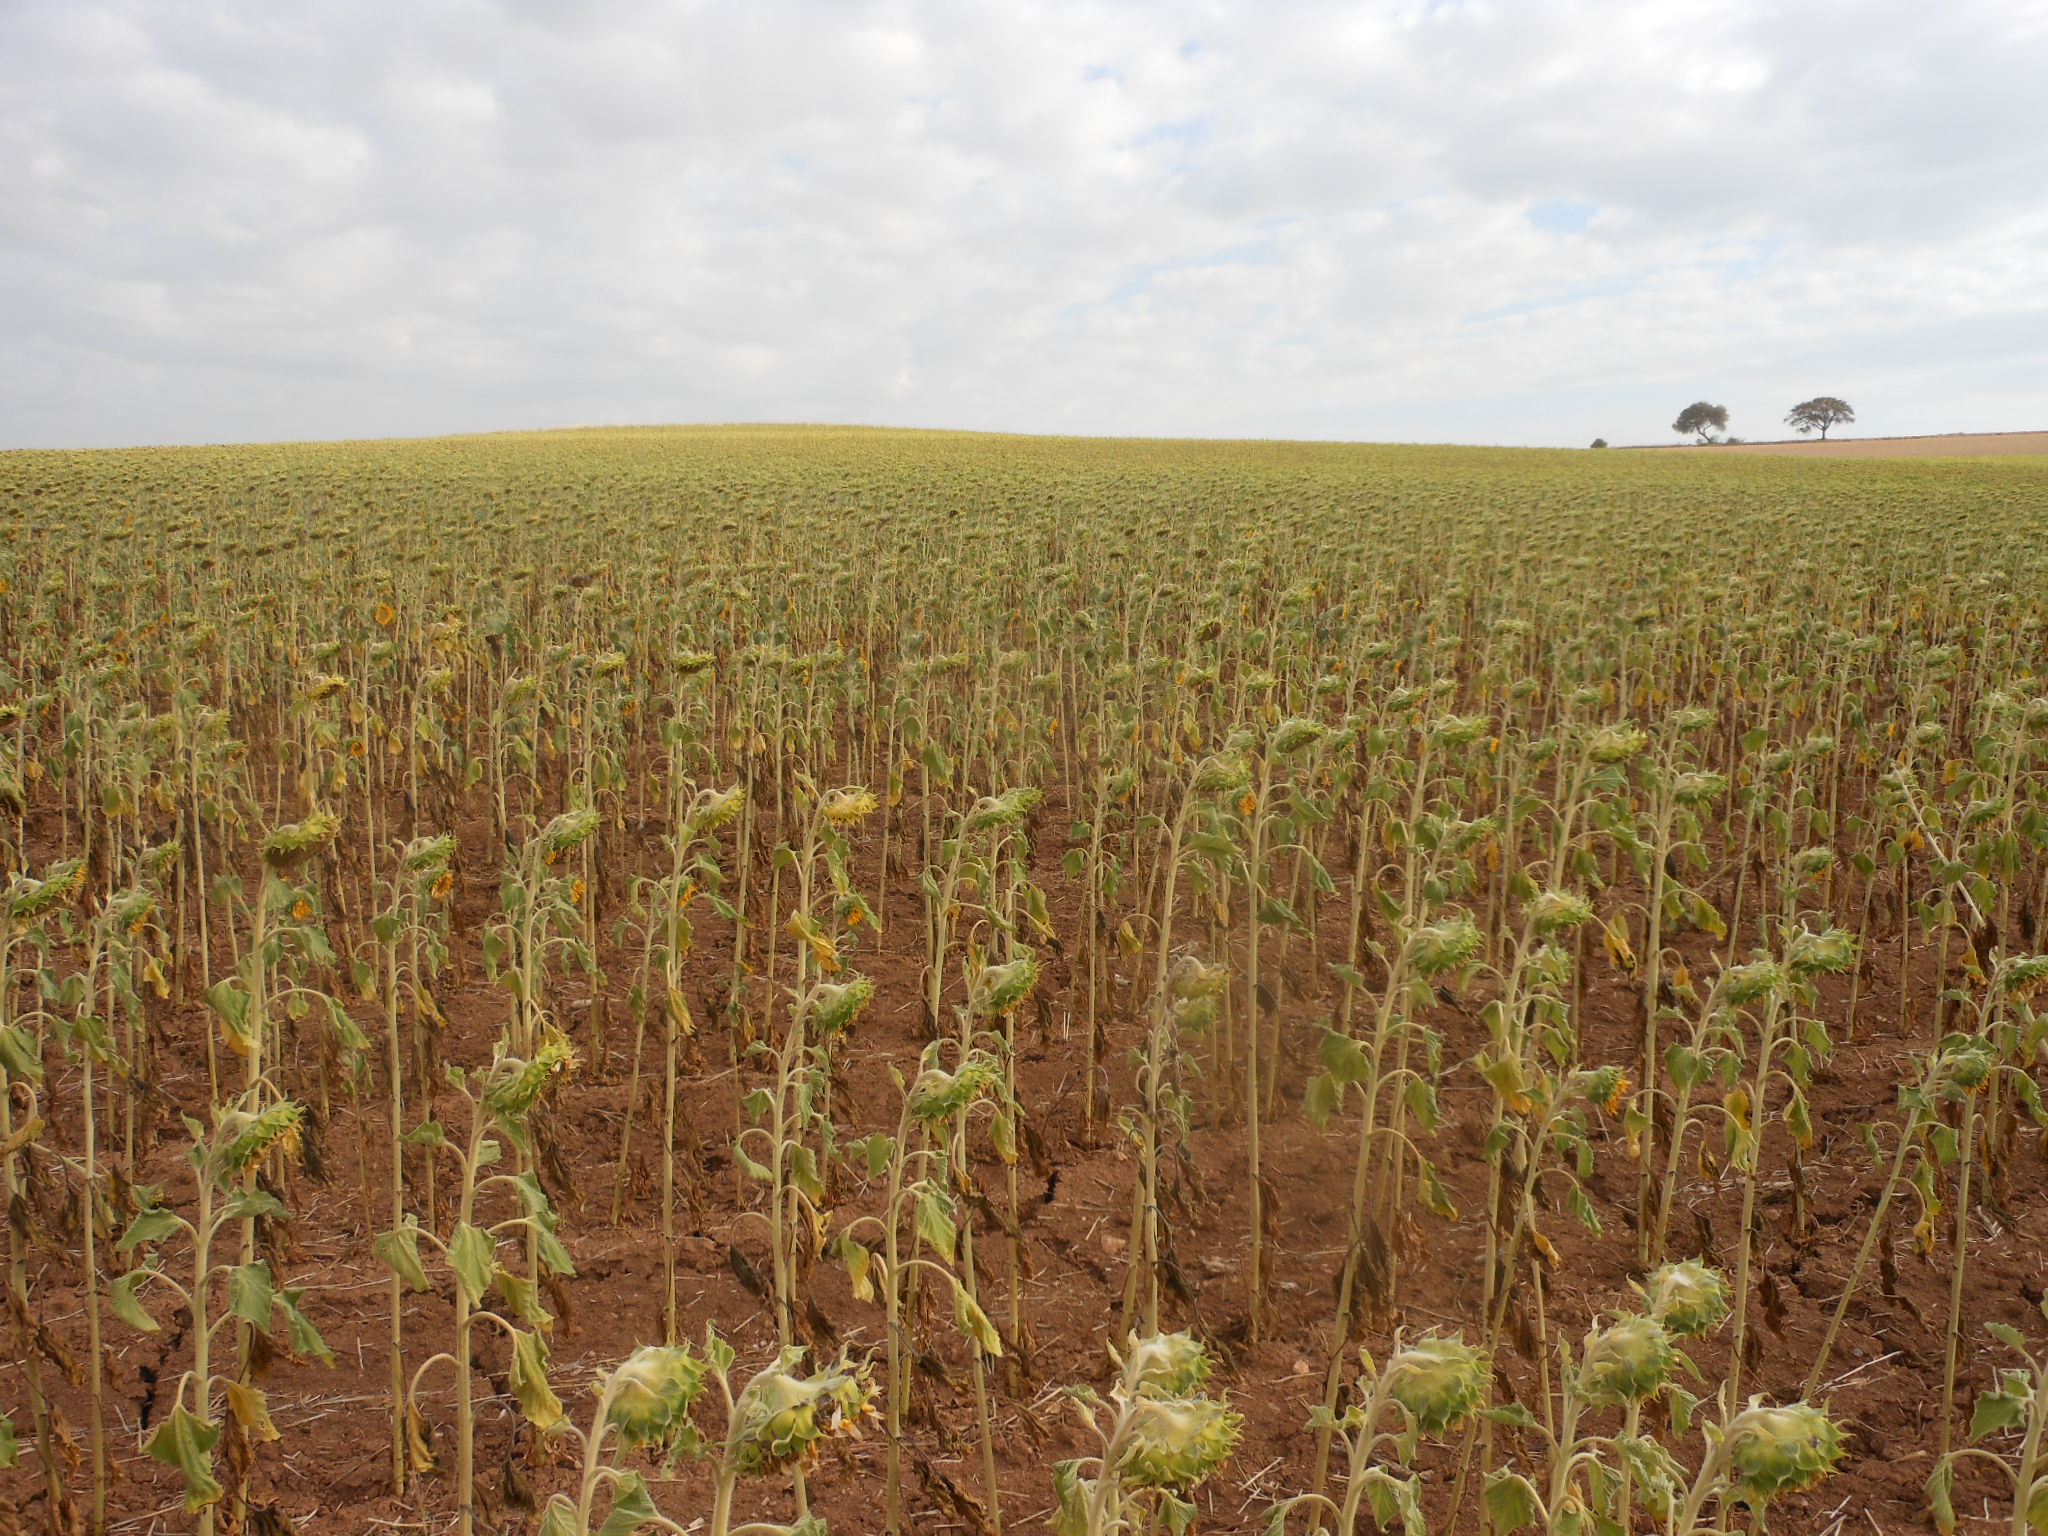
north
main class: Cropland
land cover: Sunflower
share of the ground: 50 - 75 %
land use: Agriculture (excluding fallow land and kitchen gardens)
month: June
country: ES
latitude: 37.3298
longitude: -5.0755
